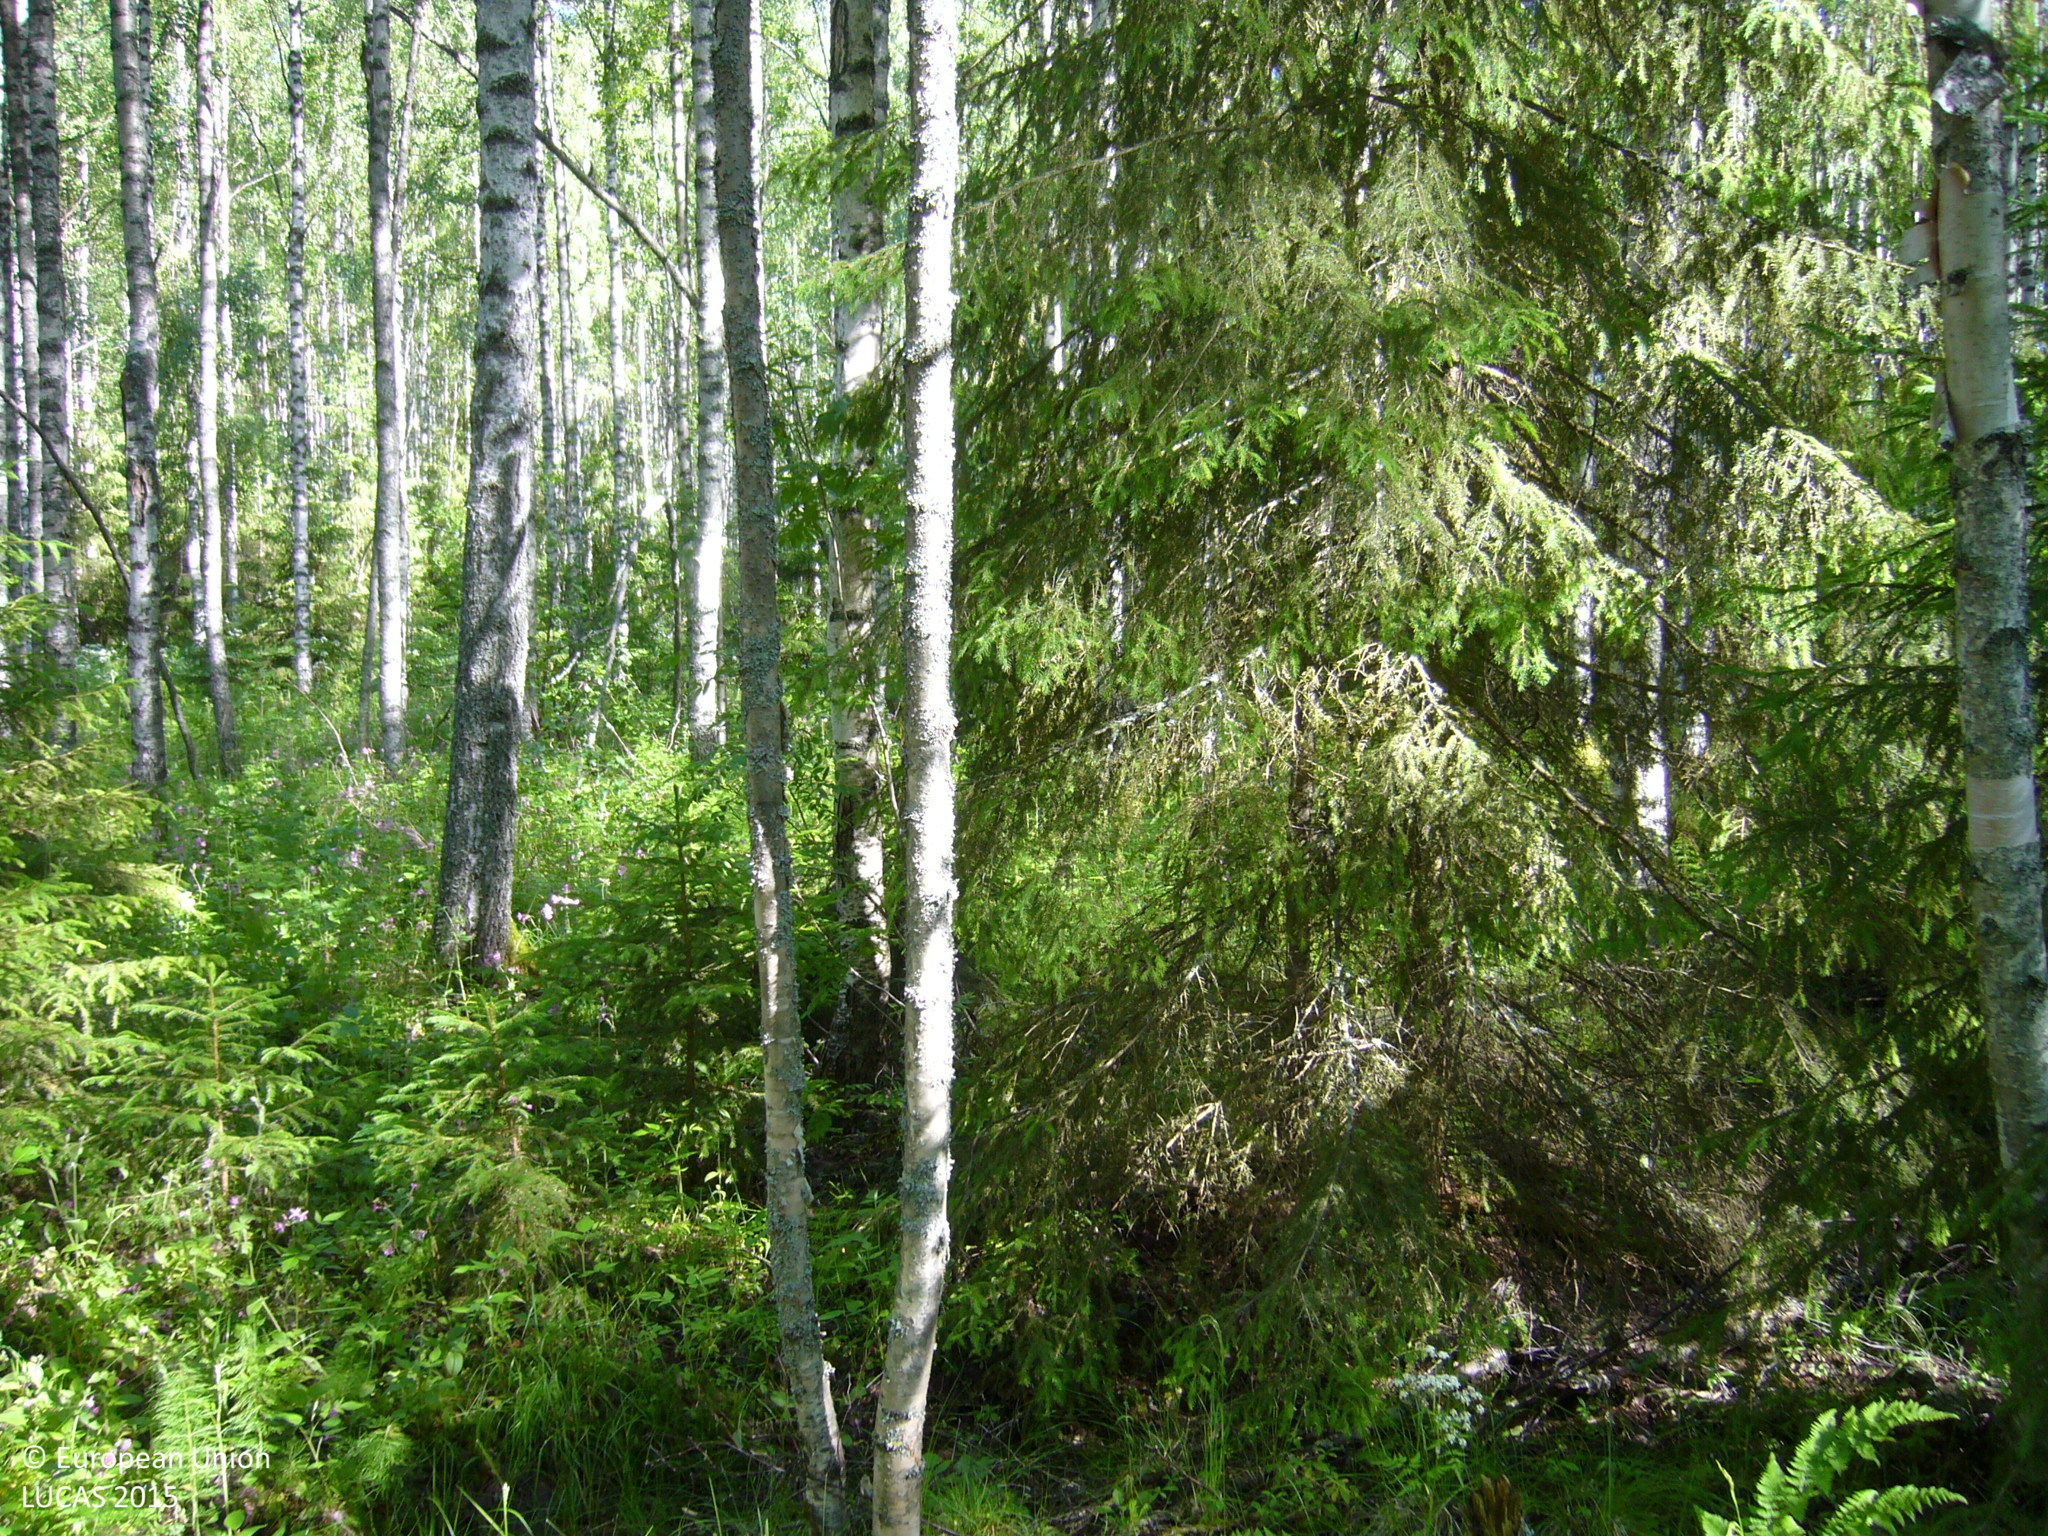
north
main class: Woodland
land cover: Spruce dominated mixed woodland
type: boreal forest
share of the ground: > 75 %
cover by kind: broadleaved forest trees 60 %, coniferous forest trees 25 %, shrubs 15 %
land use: Forestry
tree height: > 5 m
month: June
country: FI
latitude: 63.8240
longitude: 26.4784
